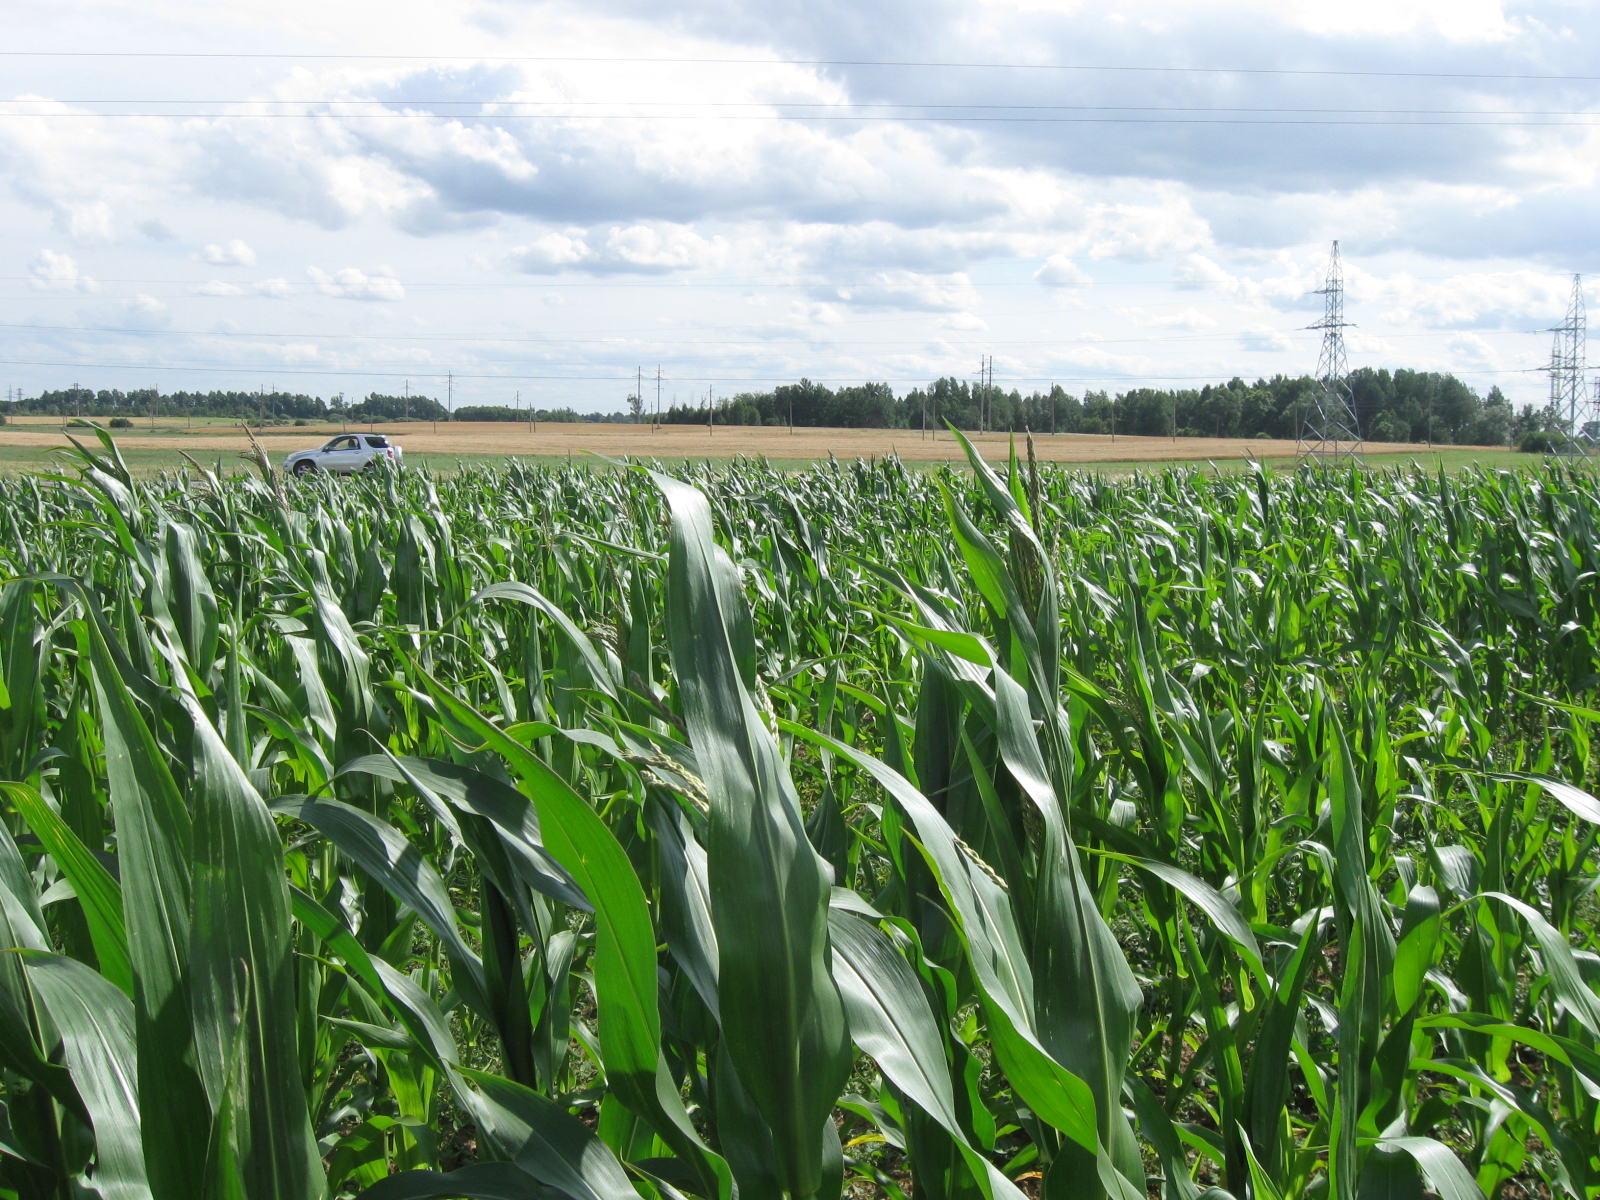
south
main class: Cropland
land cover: Maize
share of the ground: > 75 %
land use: Agriculture (excluding fallow land and kitchen gardens)
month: July
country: LT
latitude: 54.3790
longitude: 23.4605
